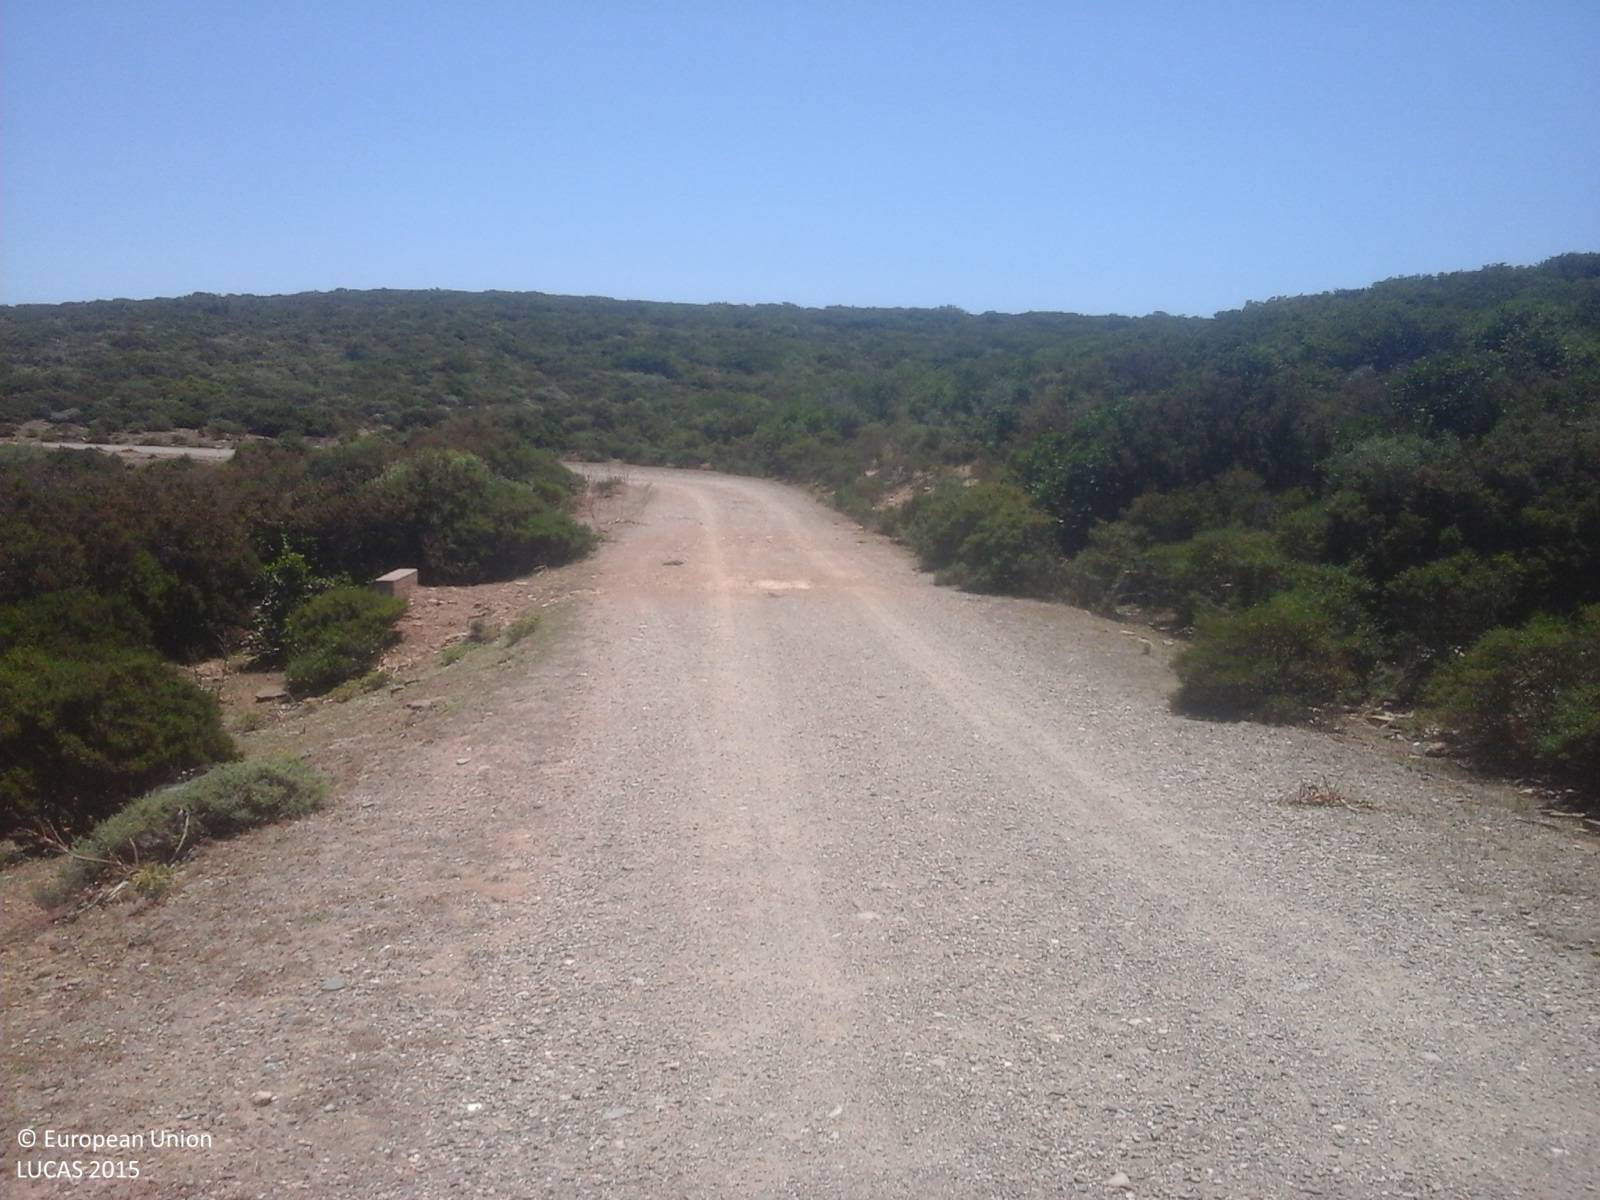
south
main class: Shrubland
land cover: Shrubland without tree cover
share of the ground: > 75 %
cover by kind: shrubs 75 %, herbaceous plants 15 %, unconsolidated bare surface 10 %
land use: Agriculture (excluding fallow land and kitchen gardens)
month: July
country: IT
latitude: 39.4501
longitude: 9.3416
